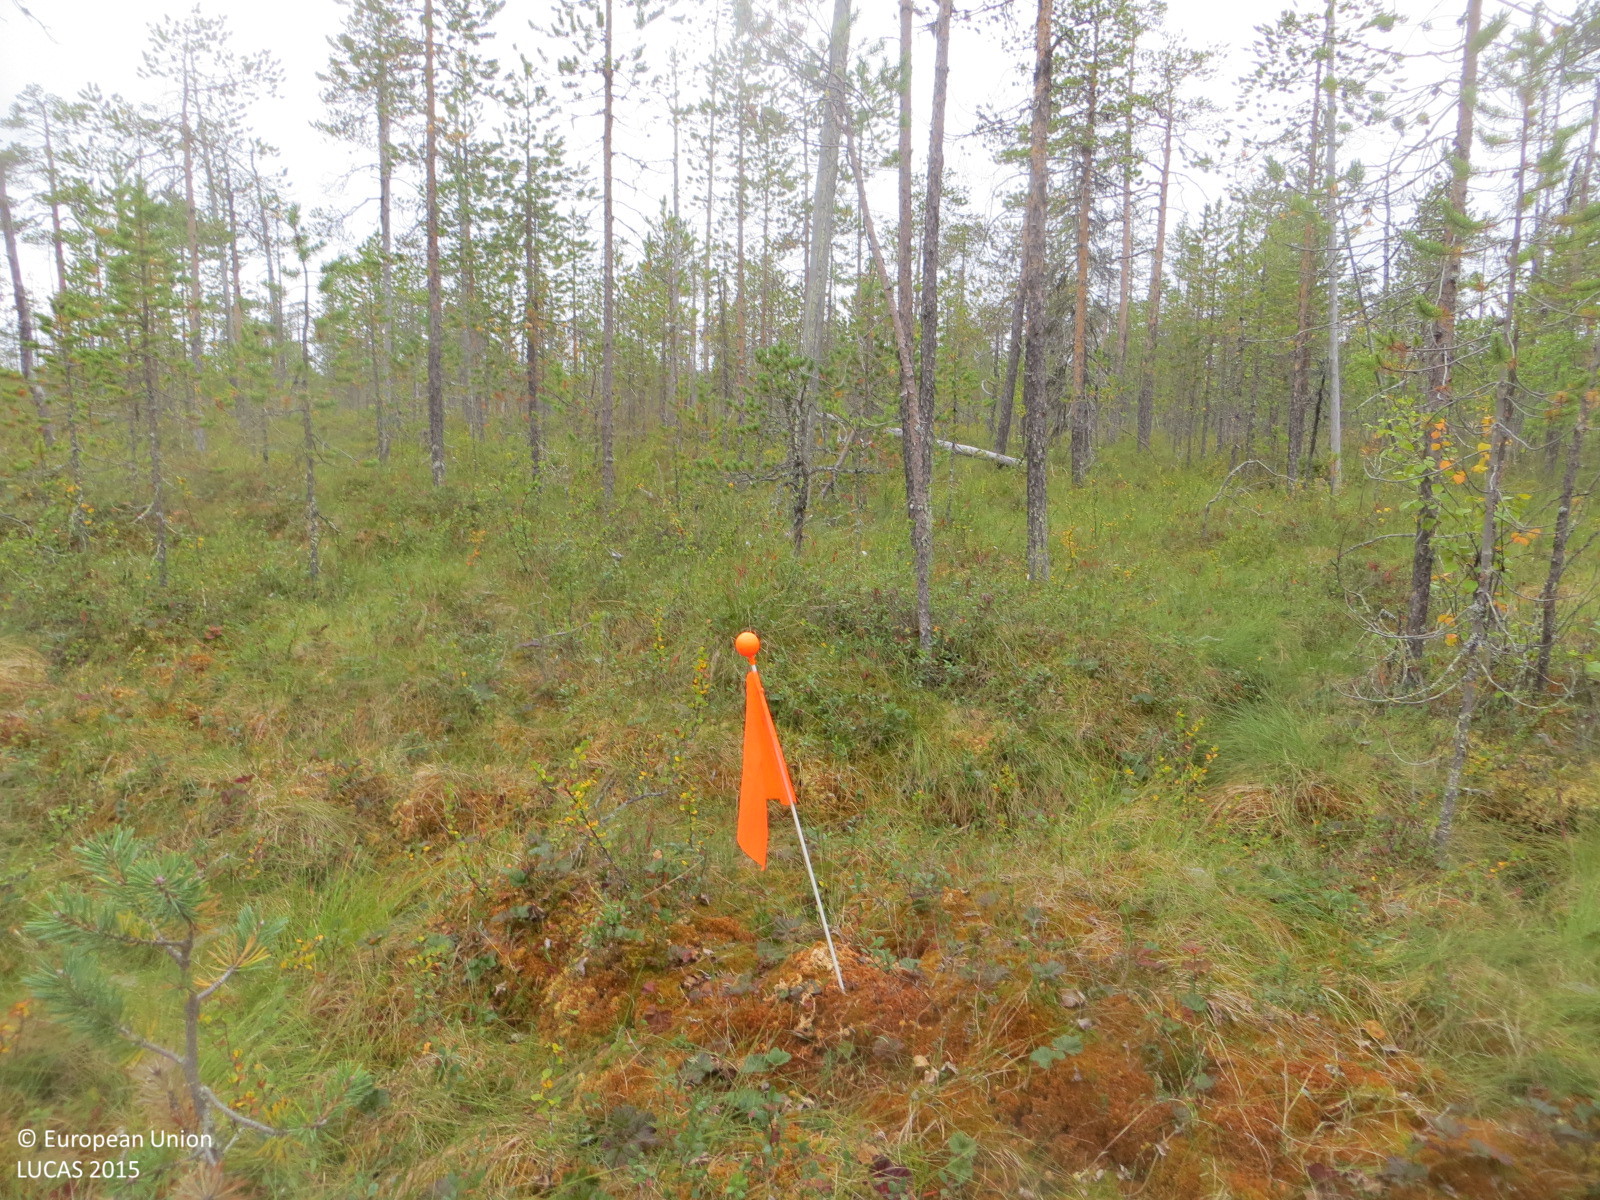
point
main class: Woodland
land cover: Pine dominated coniferous woodland
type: mire and swamp forests
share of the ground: 25 - 50 %
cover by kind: shrubs 50 %, coniferous forest trees 25 %, herbaceous plants 20 %, lichens and mosses 5 %
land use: Semi-natural and natural areas not in use
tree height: > 5 m
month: August
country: FI
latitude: 67.3997
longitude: 23.8497
